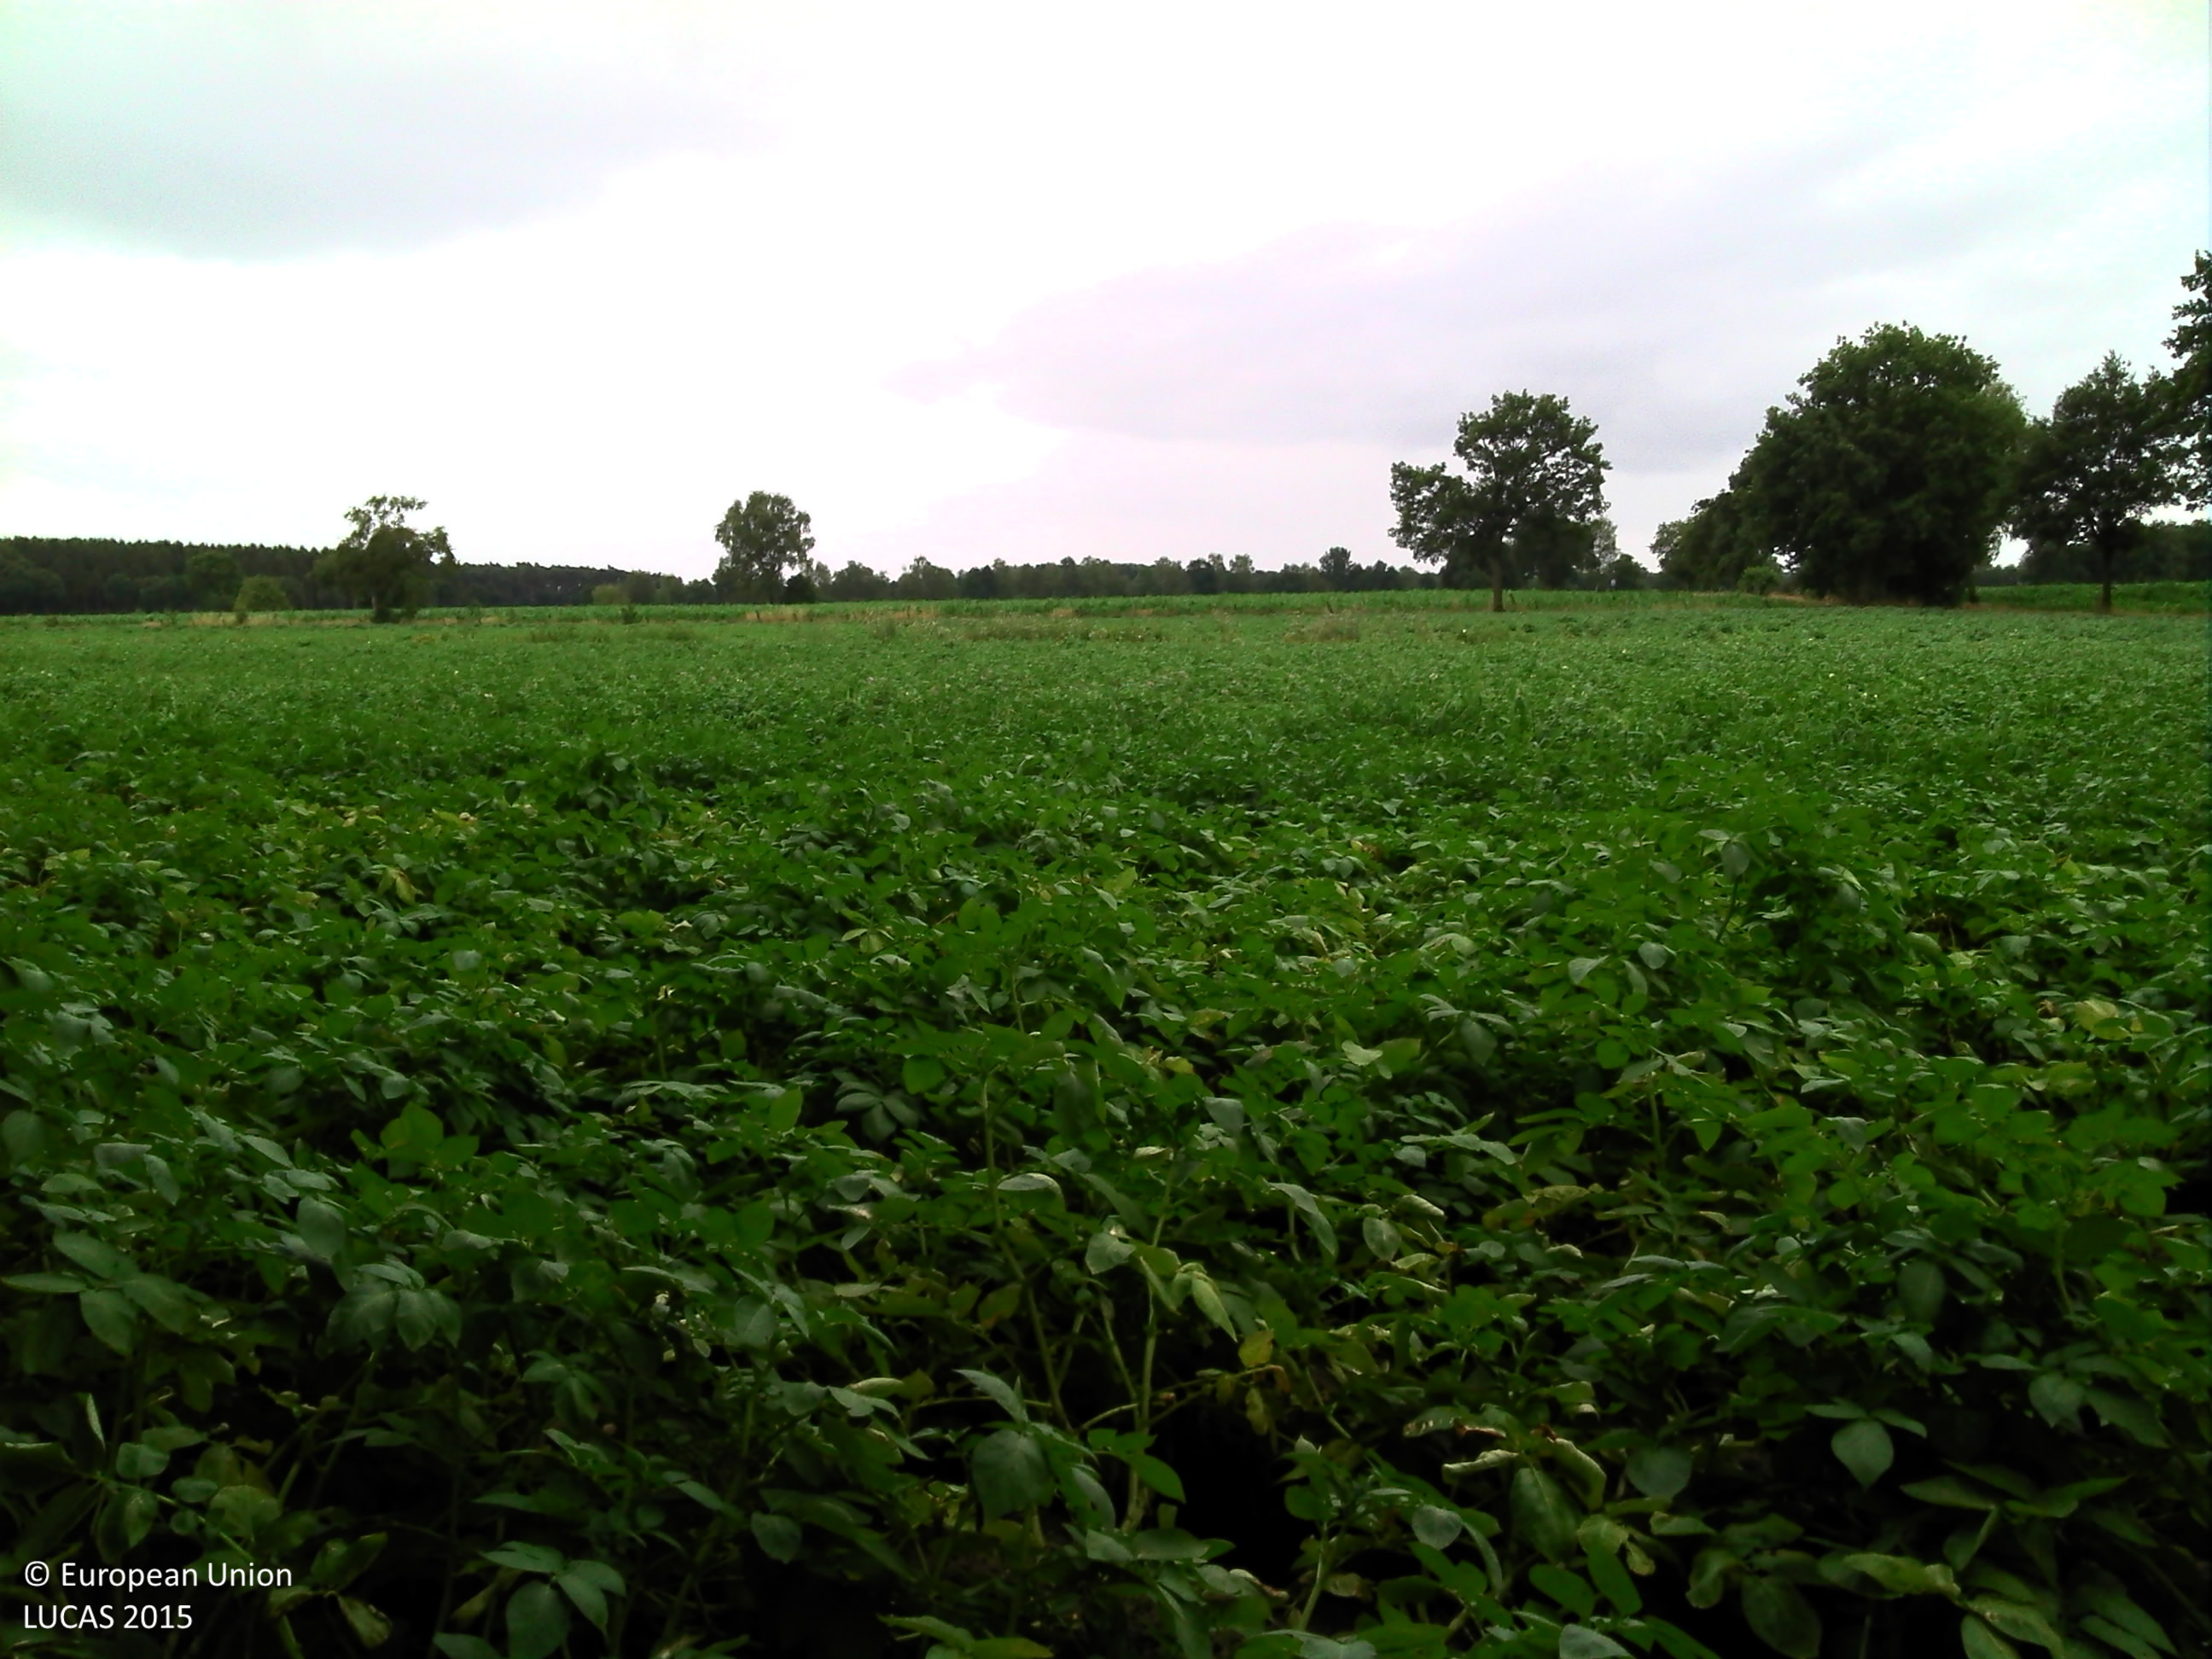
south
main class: Cropland
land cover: Potatoes
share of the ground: > 75 %
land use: Agriculture (excluding fallow land and kitchen gardens)
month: July
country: BE
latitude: 51.2104
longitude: 5.4603
